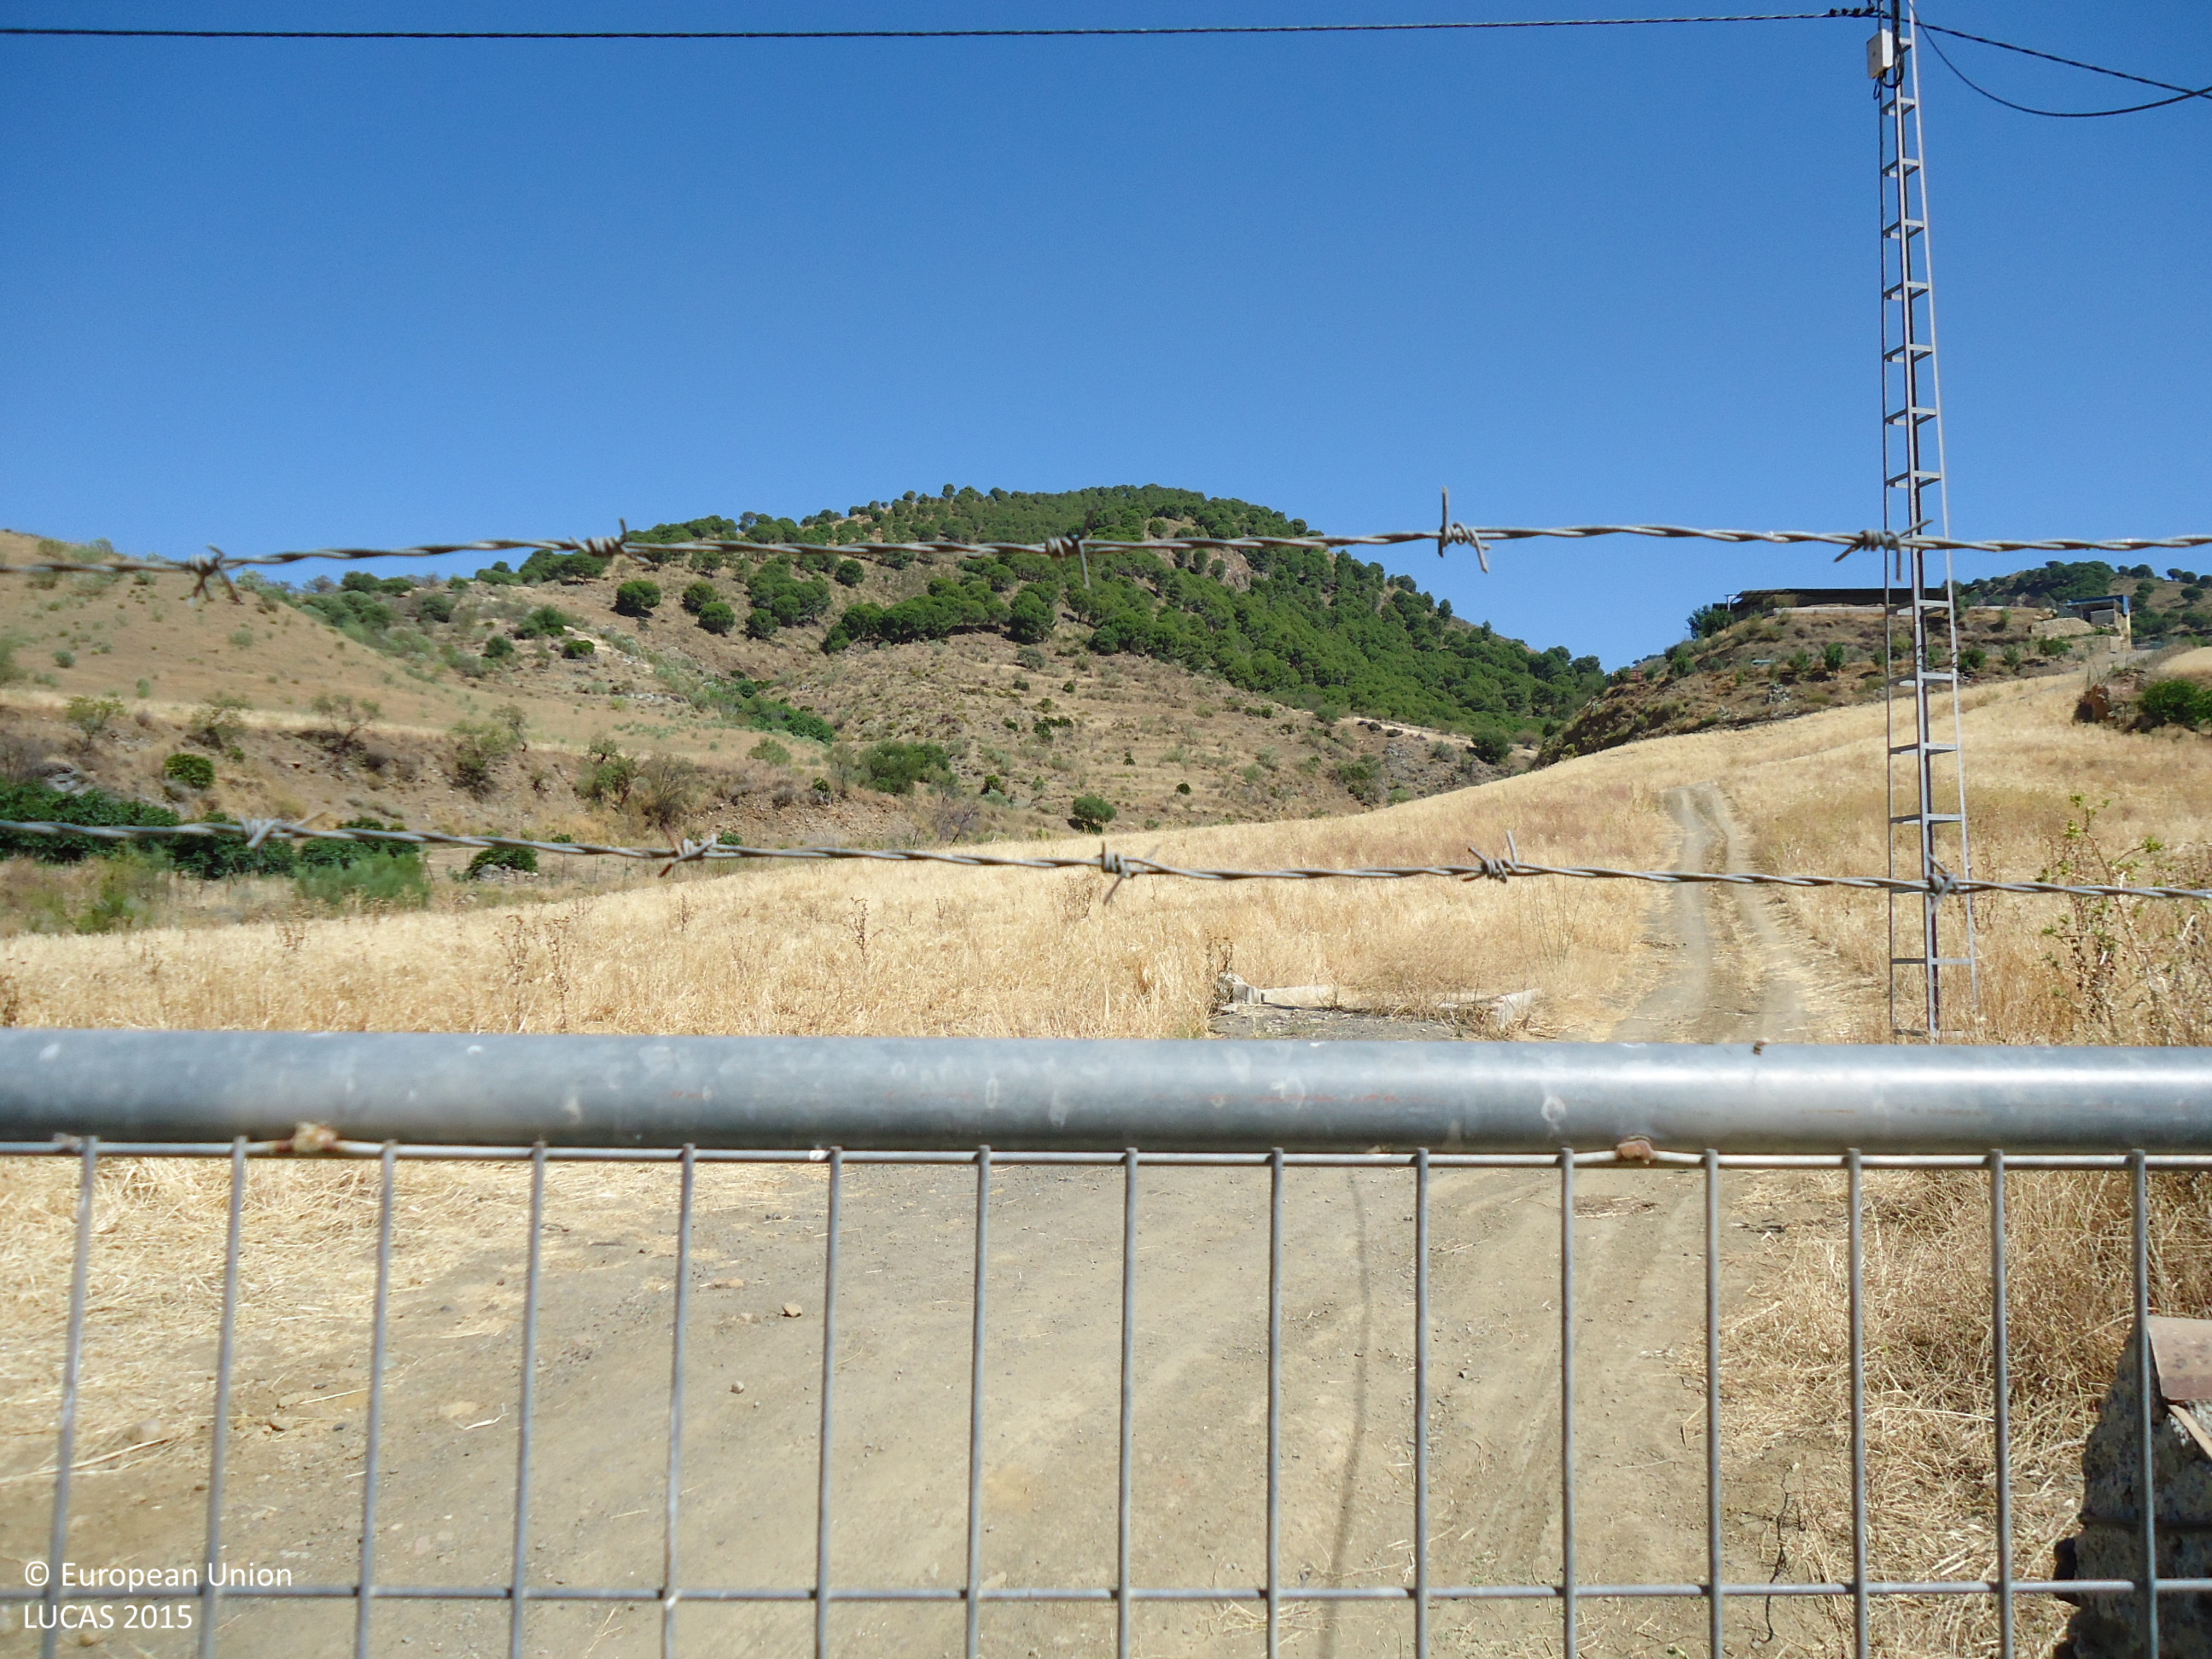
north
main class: Grassland
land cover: Grassland without tree/shrub cover
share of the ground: > 75 %
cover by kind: herbaceous plants 100 %
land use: Agriculture (excluding fallow land and kitchen gardens)
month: June
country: ES
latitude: 36.8244
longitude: -4.7836
